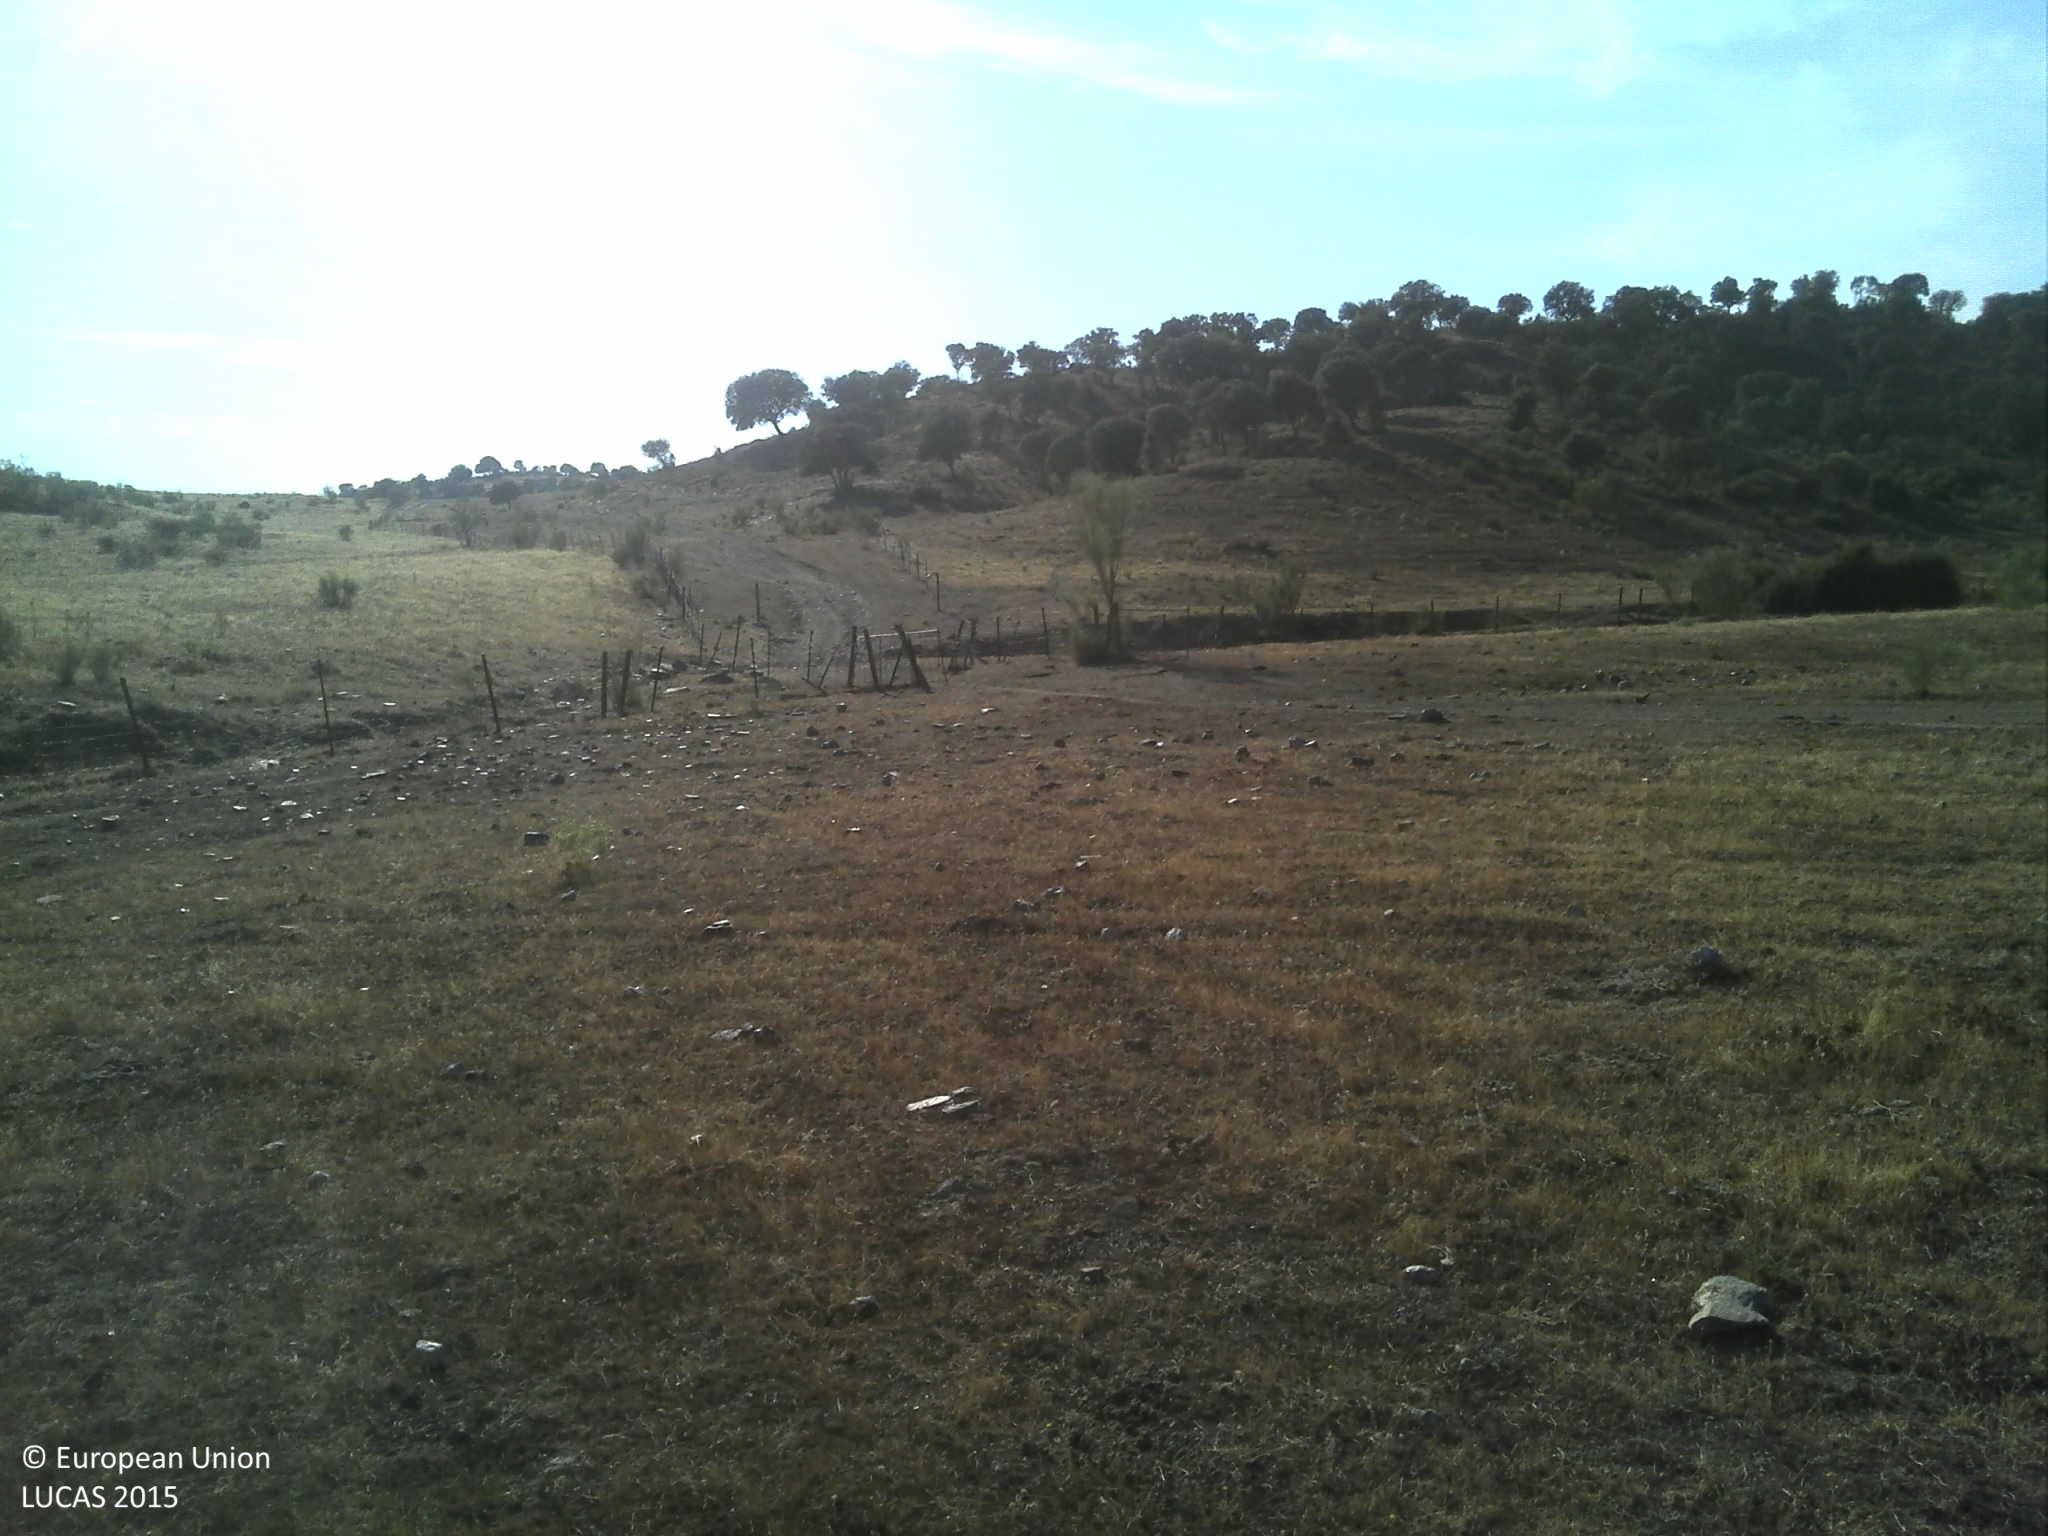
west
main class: Grassland
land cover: Grassland without tree/shrub cover
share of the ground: 10 - 25 %
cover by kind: unconsolidated bare surface 65 %, herbaceous plants 25 %, shrubs 5 %
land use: Agriculture (excluding fallow land and kitchen gardens)
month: June
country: PT
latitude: 39.8237
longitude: -6.9930
